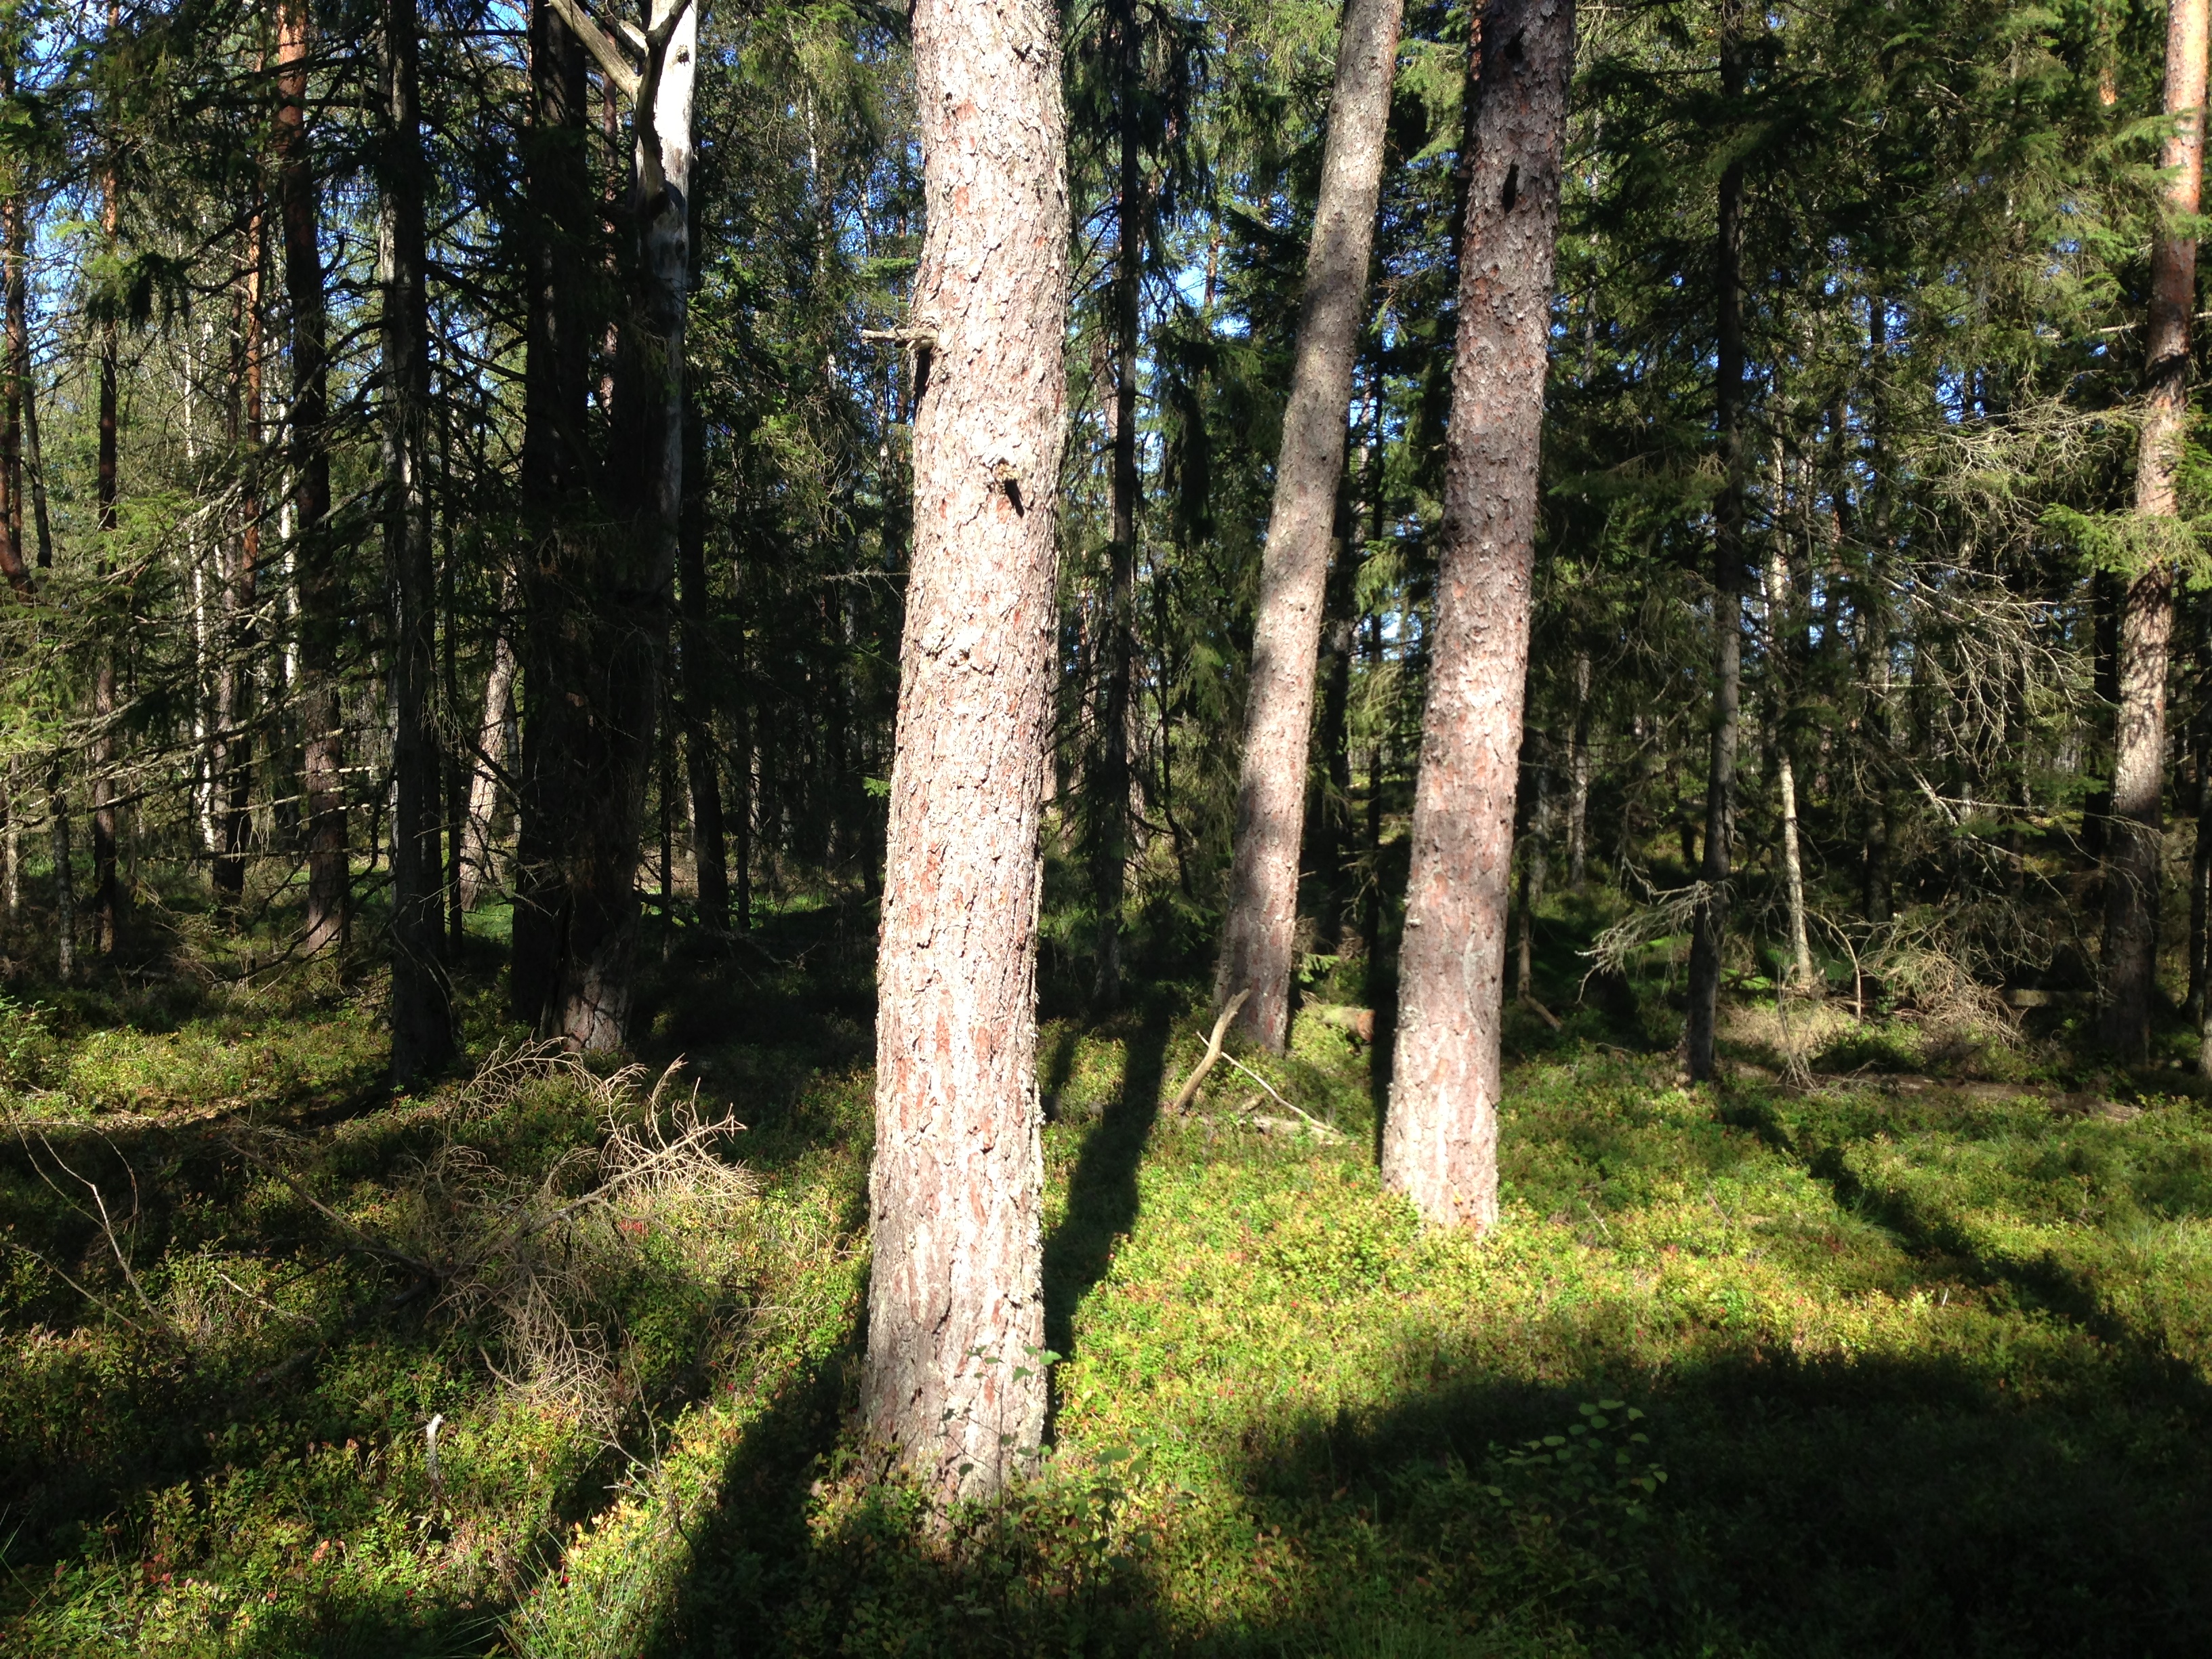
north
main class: Woodland
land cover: Pine dominated coniferous woodland
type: boreal forest
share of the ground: 50 - 75 %
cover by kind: coniferous forest trees 75 %, shrubs 25 %
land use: Forestry
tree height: > 5 m
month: September
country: SE
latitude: 57.1722
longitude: 13.2543
